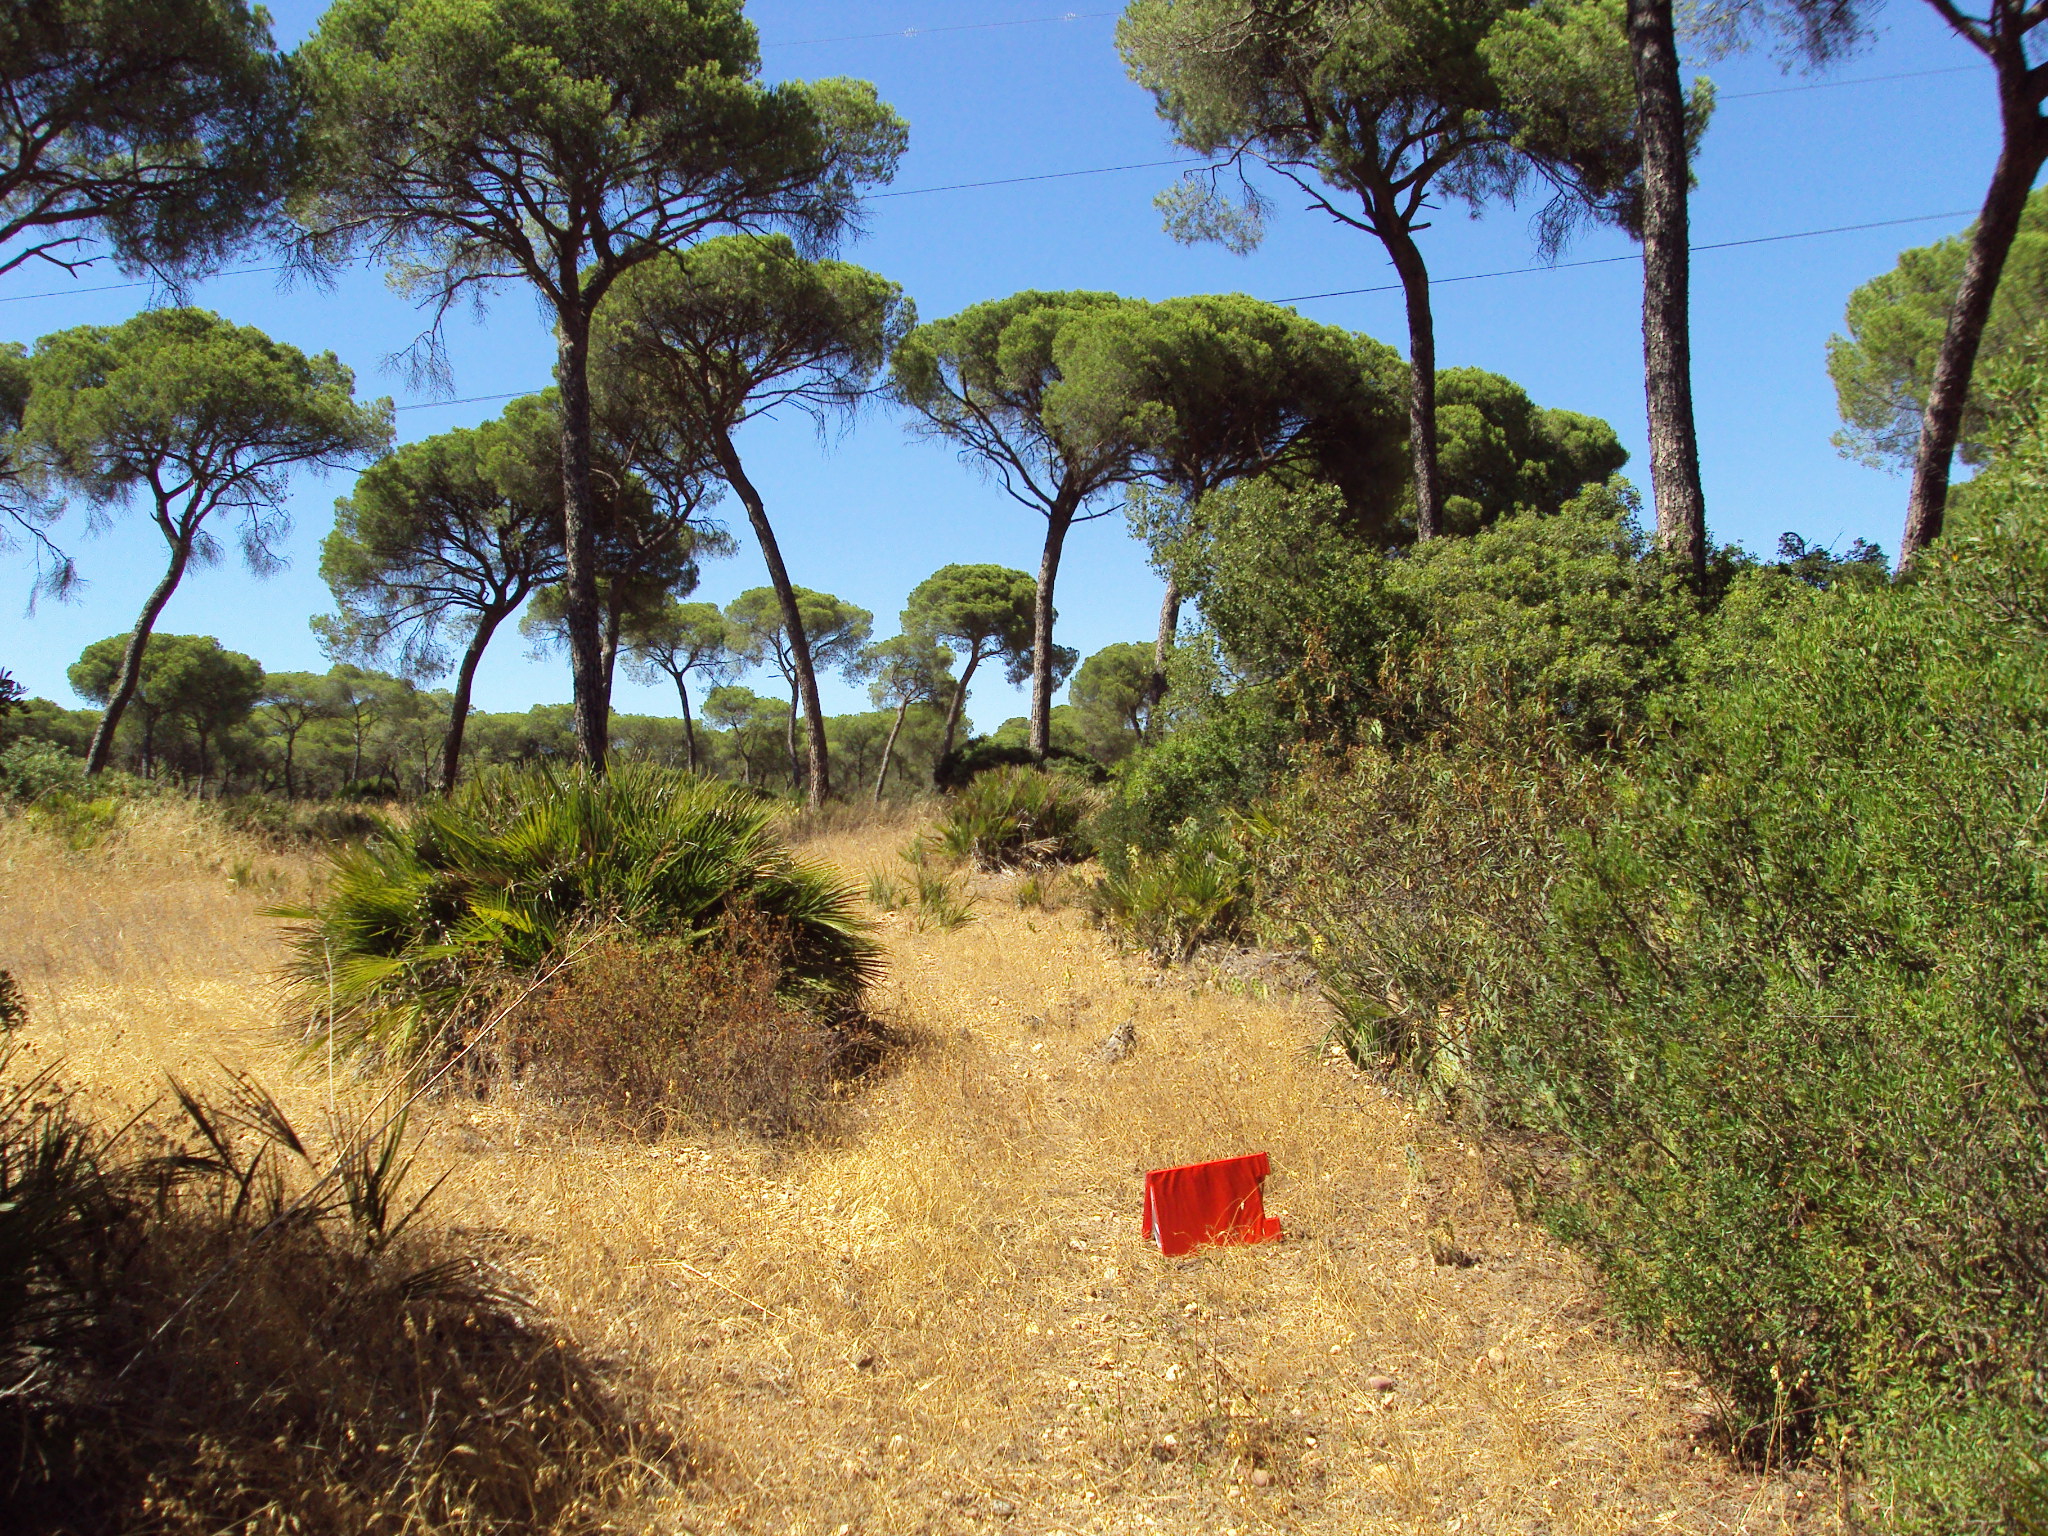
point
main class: Woodland
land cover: Pine dominated coniferous woodland
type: coniferous forest of the mediterranean region
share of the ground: 50 - 75 %
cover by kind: coniferous forest trees 70 %, herbaceous plants 20 %, shrubs 10 %
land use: Forestry
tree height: > 5 m
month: July
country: ES
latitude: 37.2136
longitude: -6.8367
